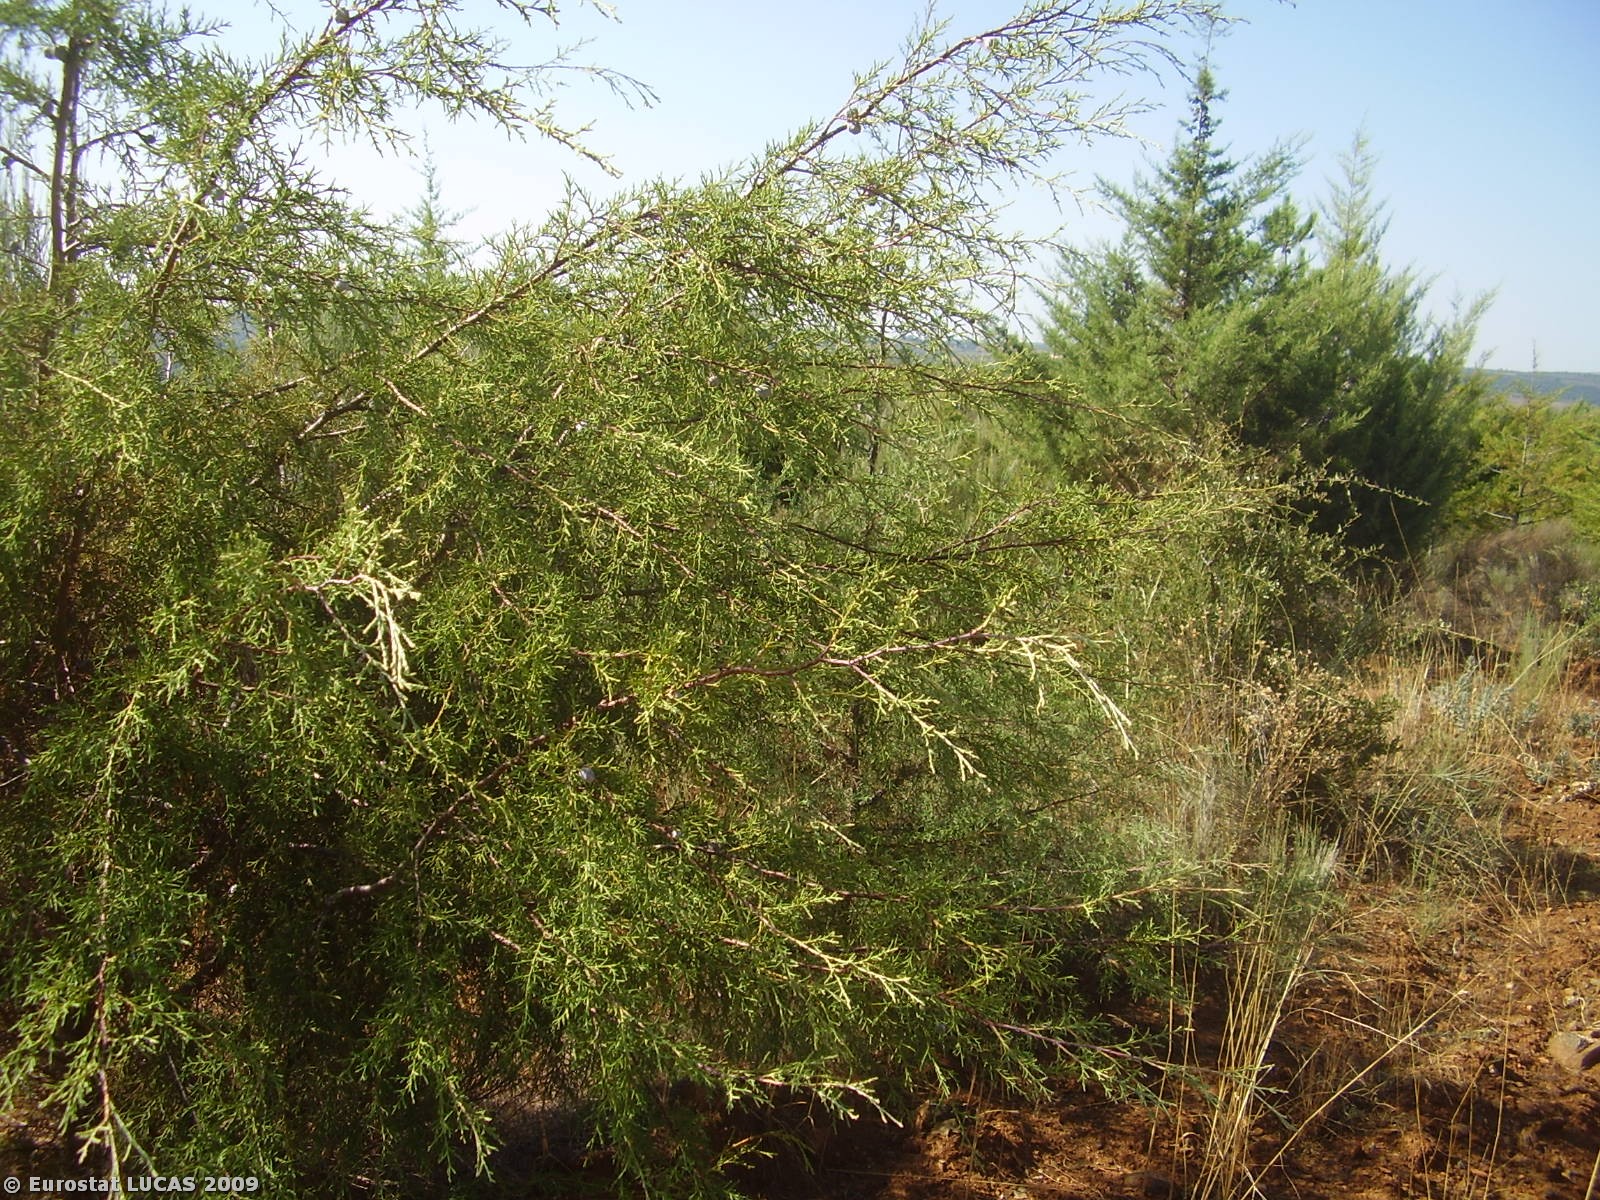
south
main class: Woodland
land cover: Coniferous woodland
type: coniferous forest of the mediterranean region
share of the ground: 25 - 50 %
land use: Forestry
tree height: > 5 m
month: August
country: PT
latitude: 41.4853
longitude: -6.8666
